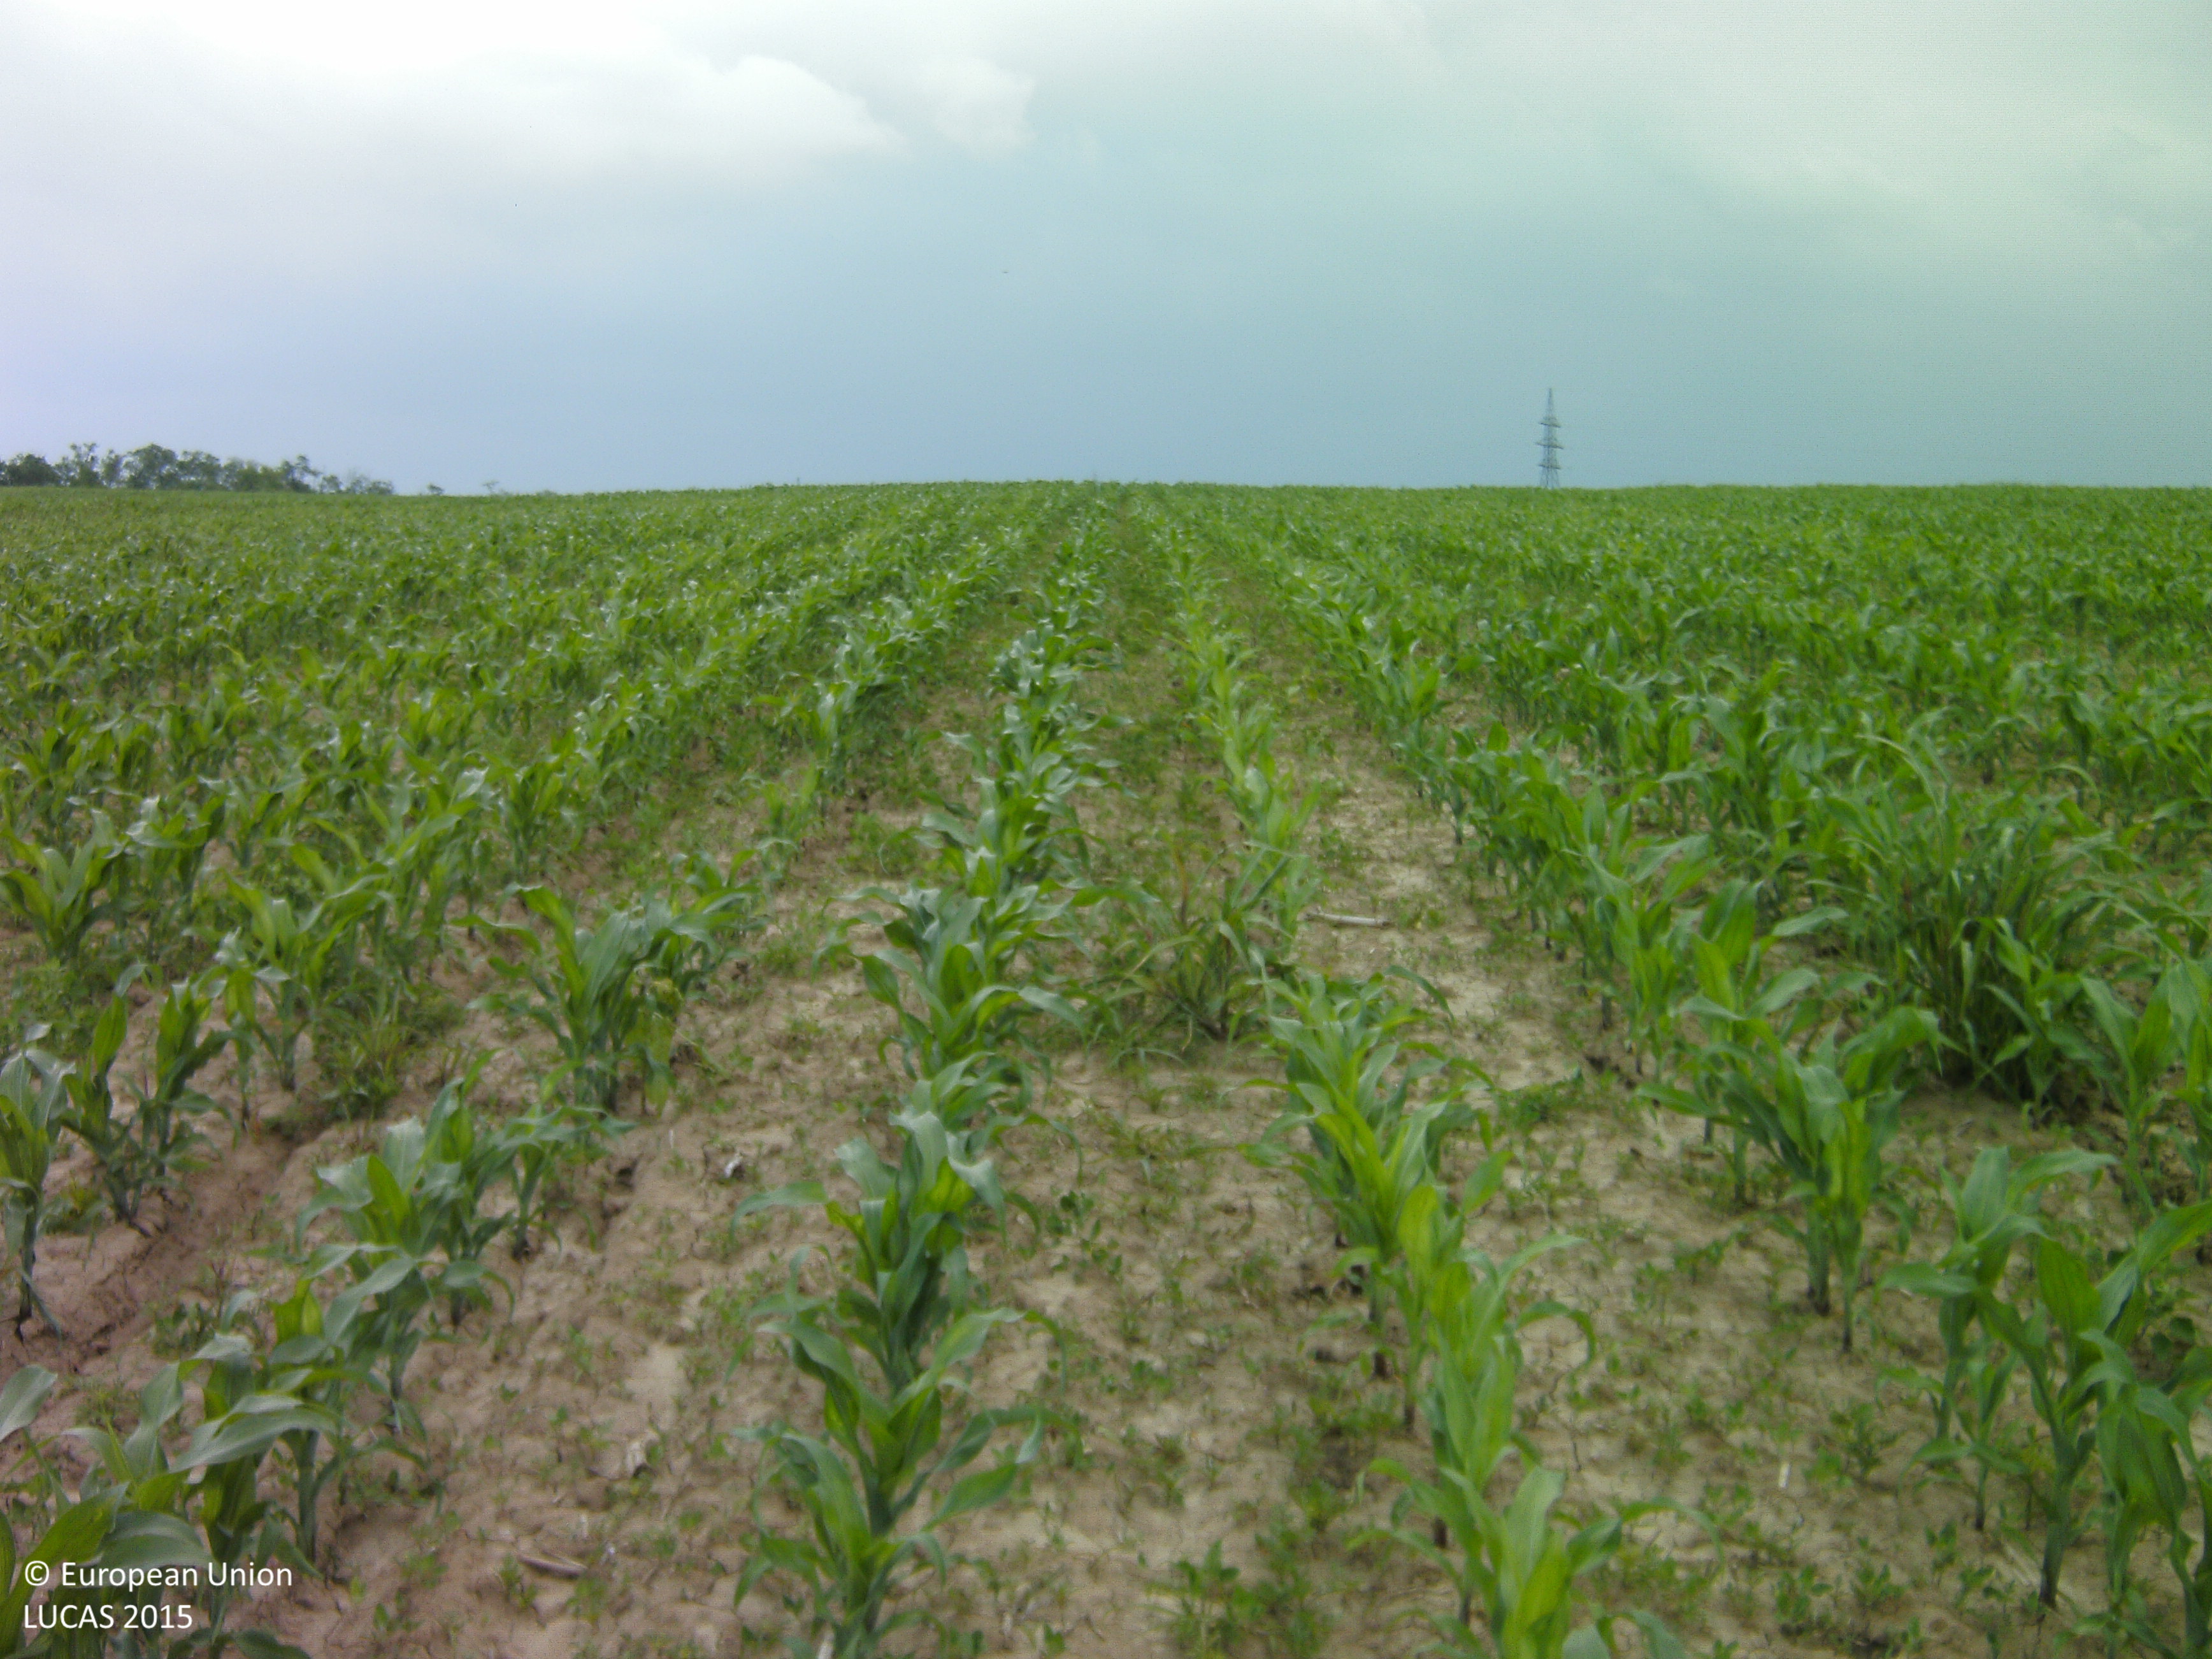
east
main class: Cropland
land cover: Maize
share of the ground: 25 - 50 %
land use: Agriculture (excluding fallow land and kitchen gardens)
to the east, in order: Maize; Soya
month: June
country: HU
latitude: 46.4081
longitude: 17.8242
